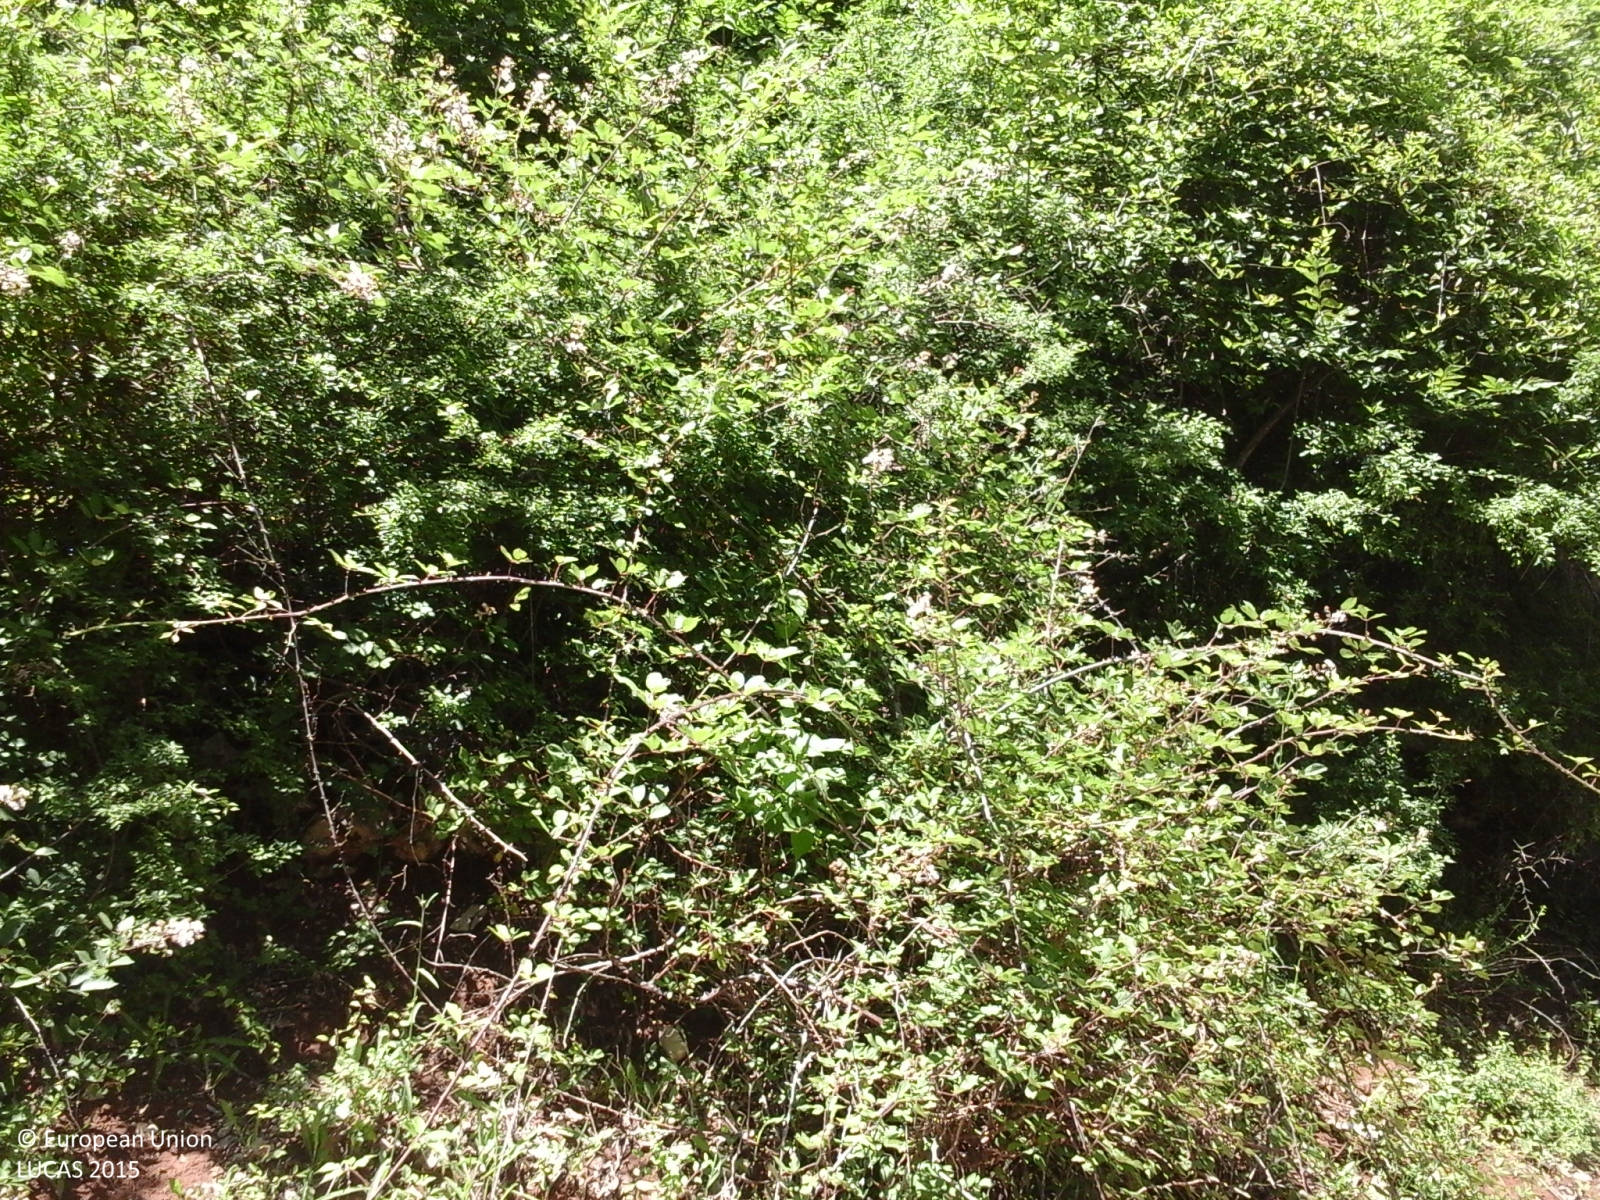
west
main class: Woodland
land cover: Broadleaved woodland
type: thermophilous deciduous forest
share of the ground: > 75 %
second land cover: Grassland without tree/shrub cover
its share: > 75 %
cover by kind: broadleaved forest trees 70 %, herbaceous plants 30 %
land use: Forestry
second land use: Agriculture (excluding fallow land and kitchen gardens)
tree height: > 5 m
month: June
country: IT
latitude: 41.6311
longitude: 13.0732
